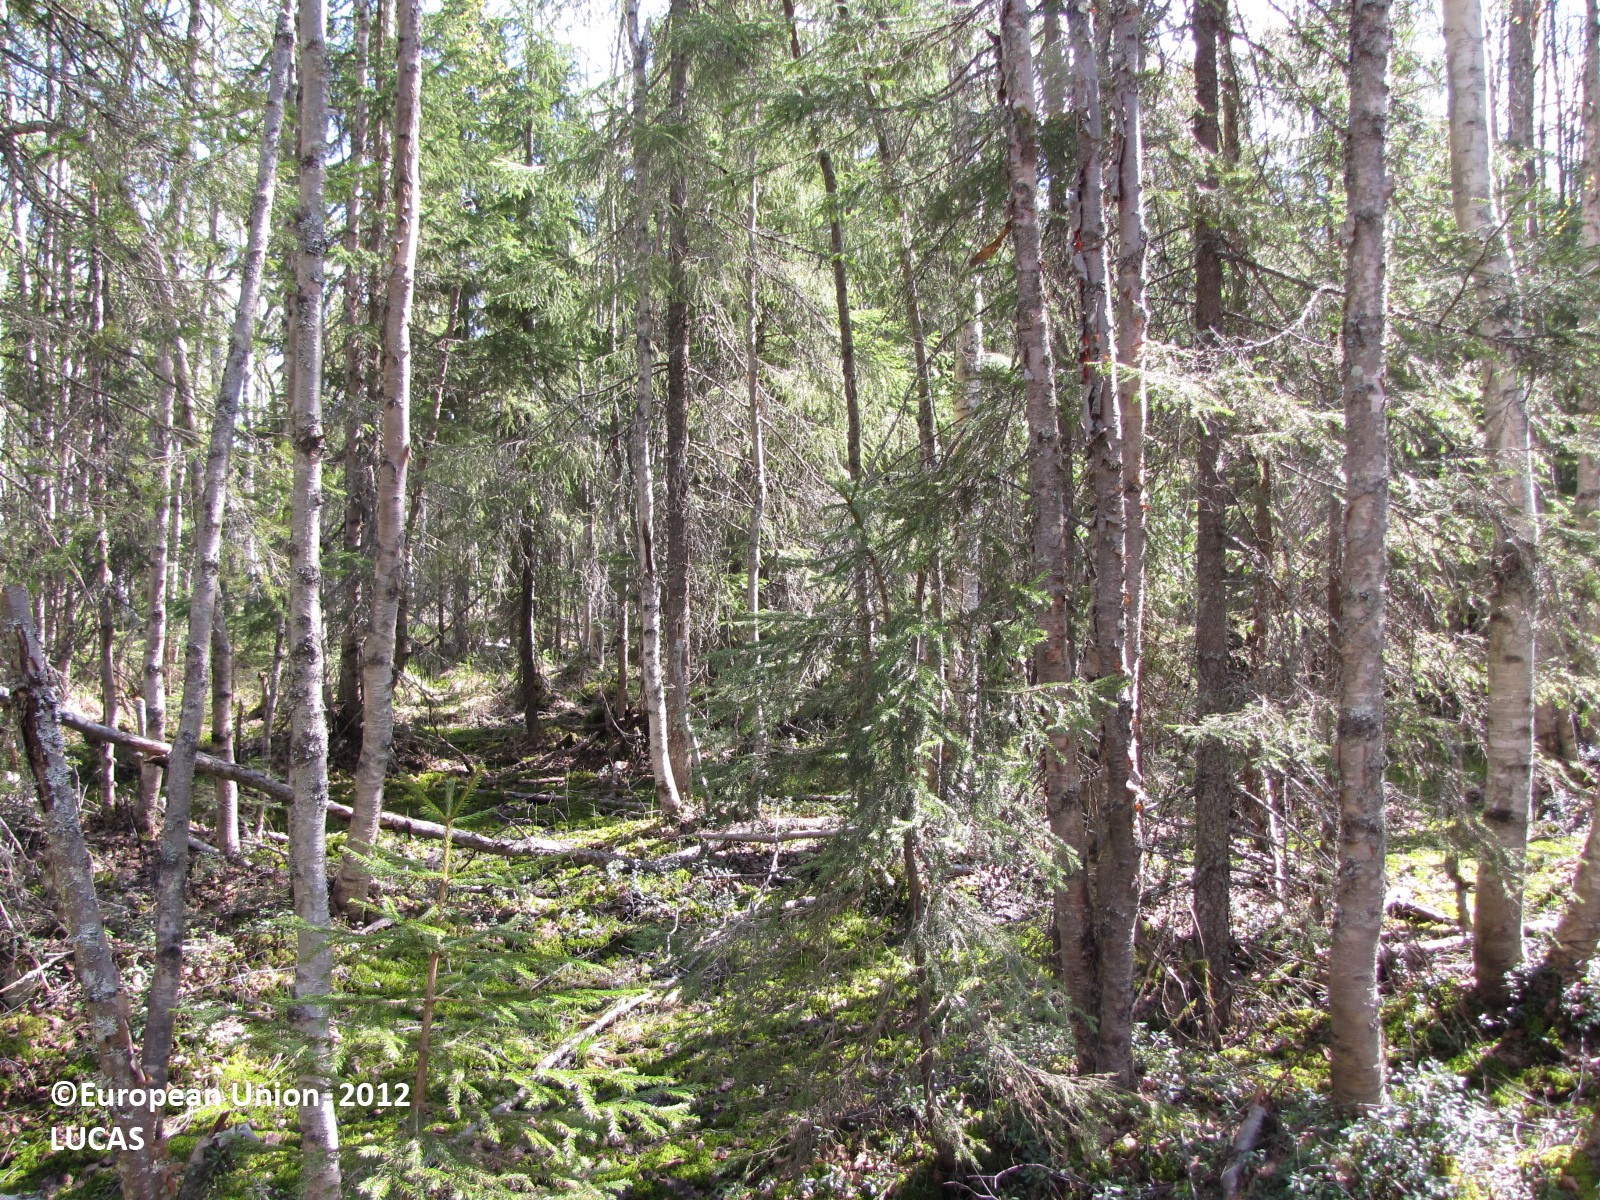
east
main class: Woodland
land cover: Spruce dominated mixed woodland
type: boreal forest
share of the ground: > 75 %
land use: Forestry
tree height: > 5 m
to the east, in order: Spruce dominated mixed woodland; Single bushes/trees; Spruce dominated mixed woodland; Ditches and canals; Spruce dominated mixed woodland; Ditches and canals; Spruce dominated mixed woodland; Ditches and canals; Spruce dominated mixed woodland; Ditches and canals; Spruce dominated mixed woodland
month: May
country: FI
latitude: 65.7431
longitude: 24.6508
